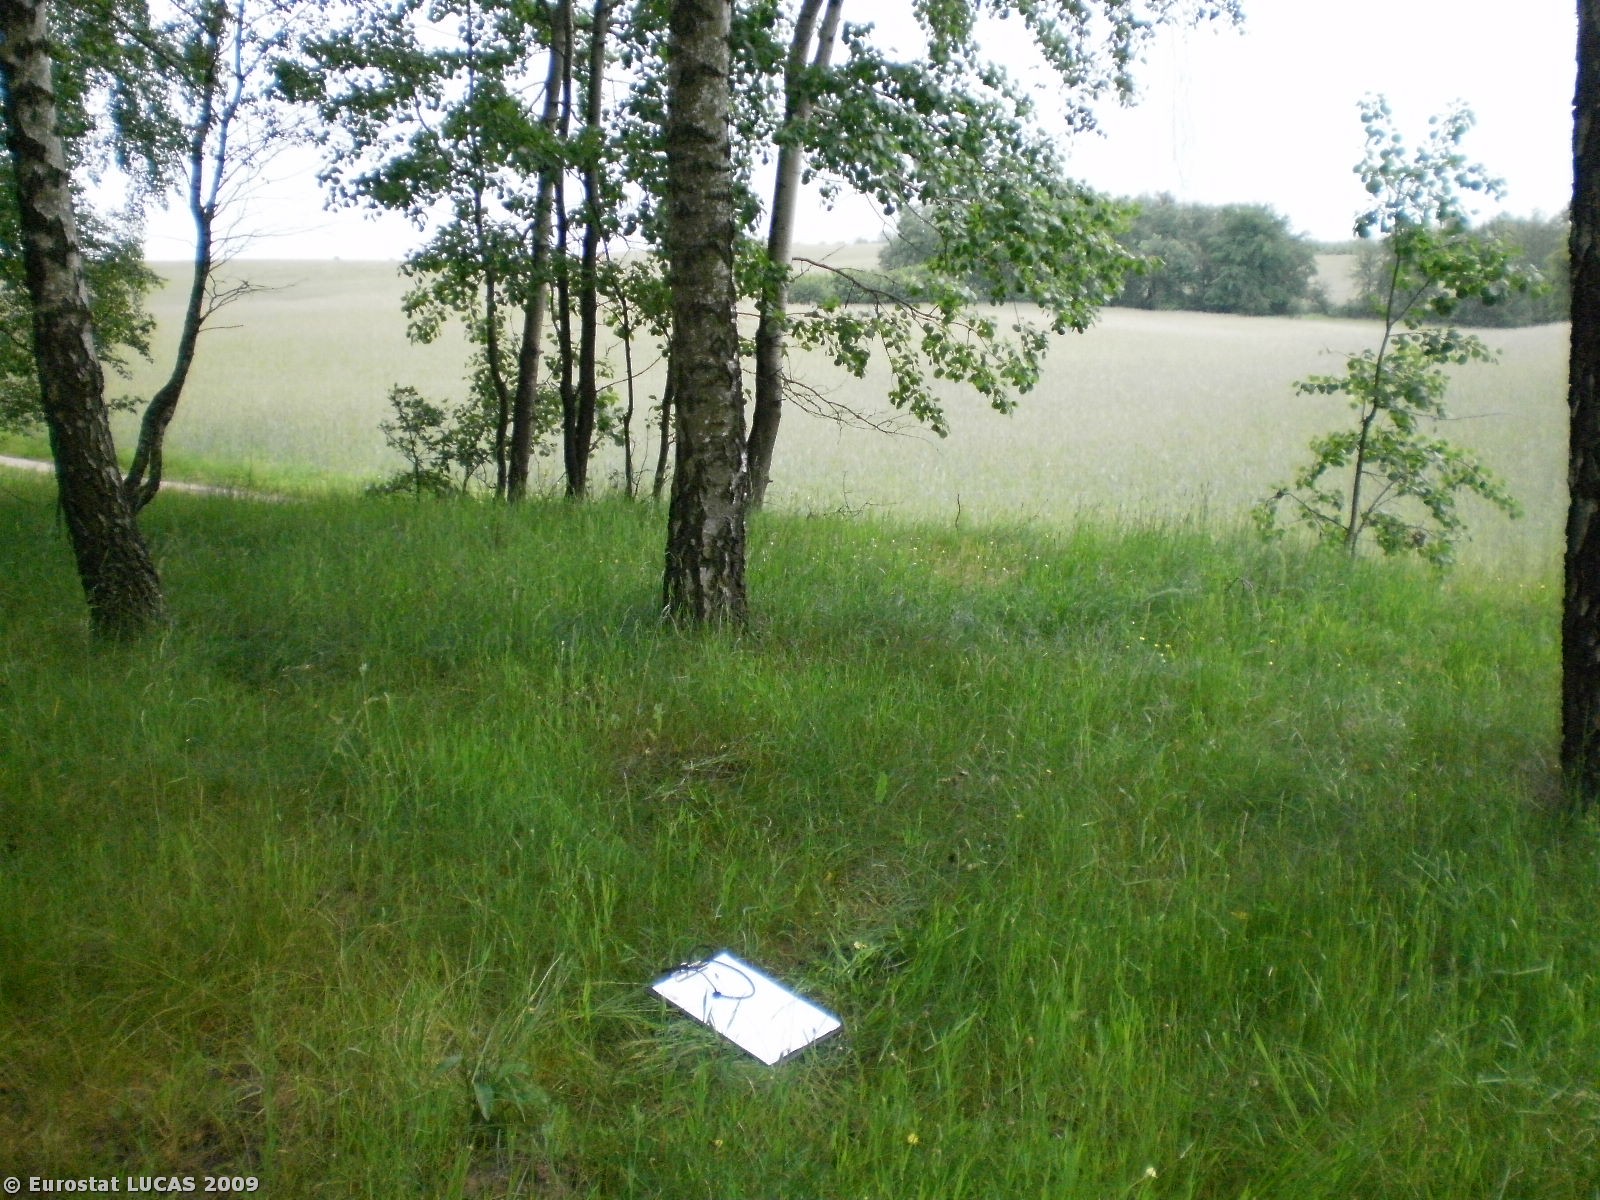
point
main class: Woodland
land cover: Mixed woodland
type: hemiboreal forest and nemoral coniferous forest and mixed broadleaved-coniferous forest
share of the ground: > 75 %
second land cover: Grassland with sparse tree/shrub cover
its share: 50 - 75 %
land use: Forestry
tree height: > 5 m
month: June
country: PL
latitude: 53.4335
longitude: 19.8592
